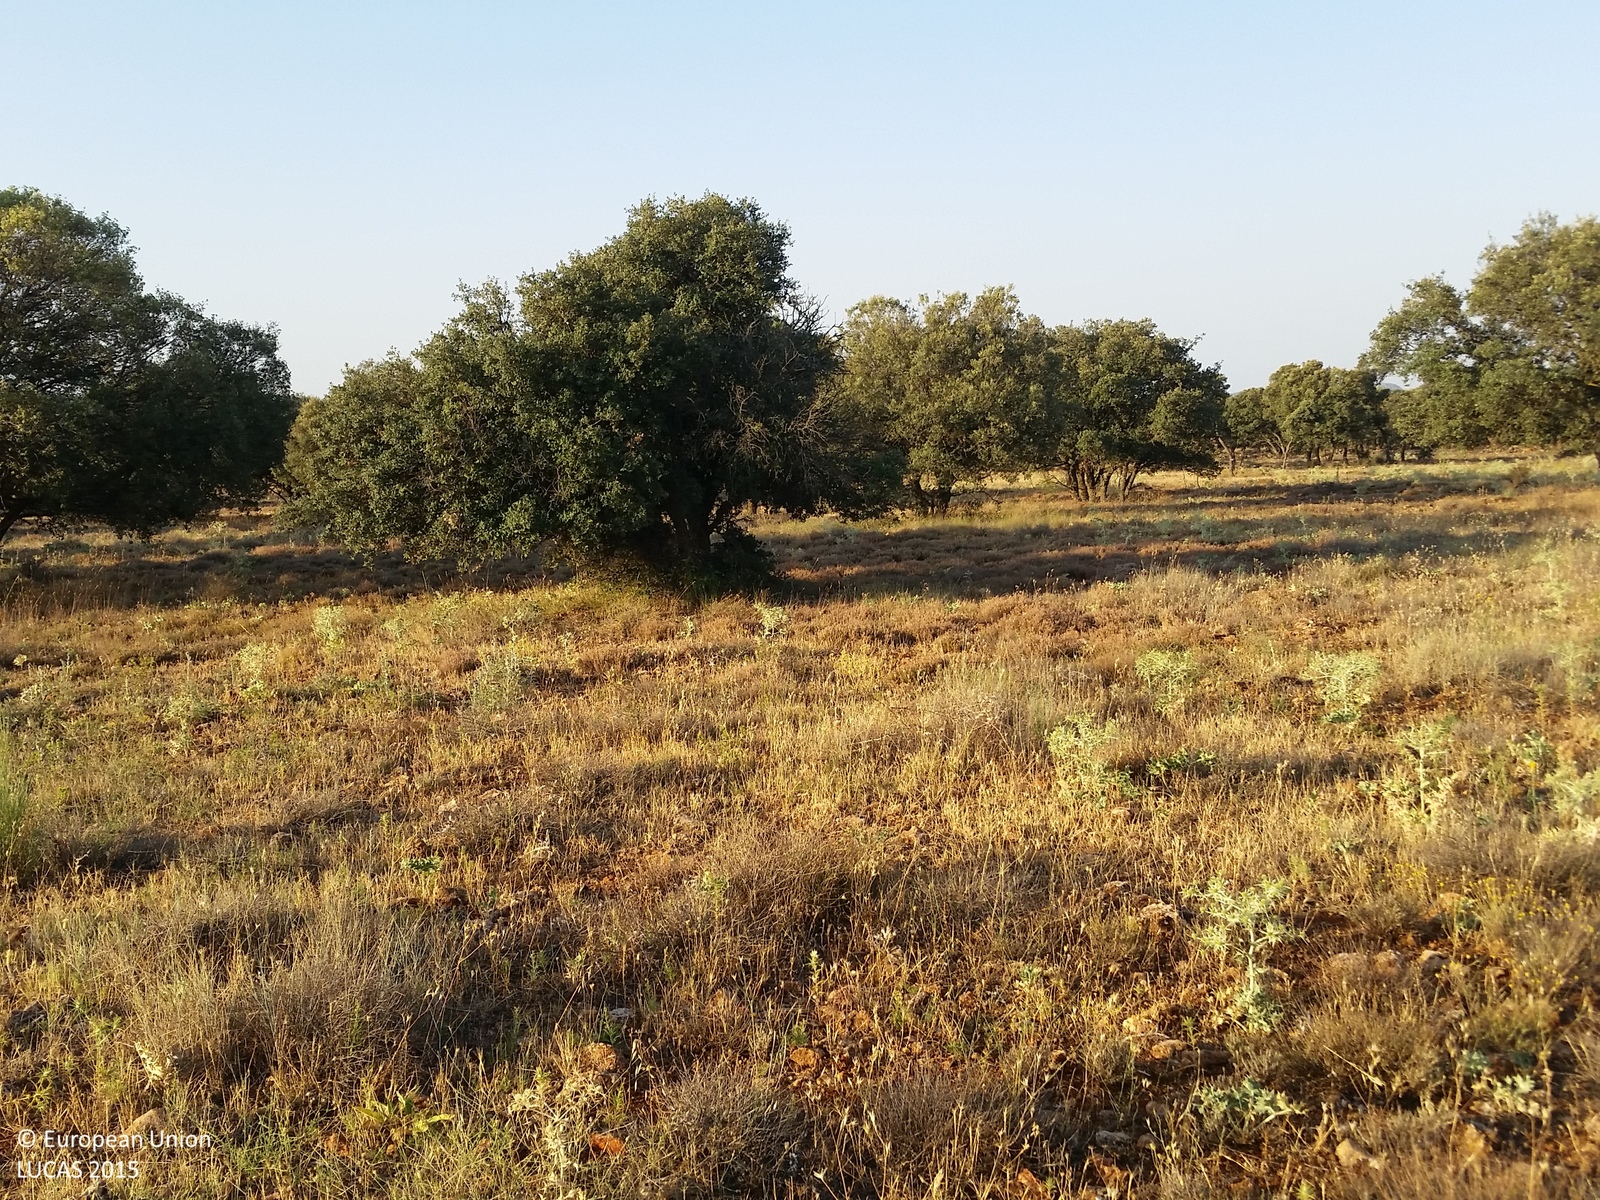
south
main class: Woodland
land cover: Broadleaved woodland
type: broadleaved evergreen forest
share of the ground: 50 - 75 %
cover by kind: broadleaved forest trees 50 %, shrubs 25 %, consolidated bare surface 15 %, herbaceous plants 10 %
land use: Semi-natural and natural areas not in use
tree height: < 5 m
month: June
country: ES
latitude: 38.7318
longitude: -2.6456
